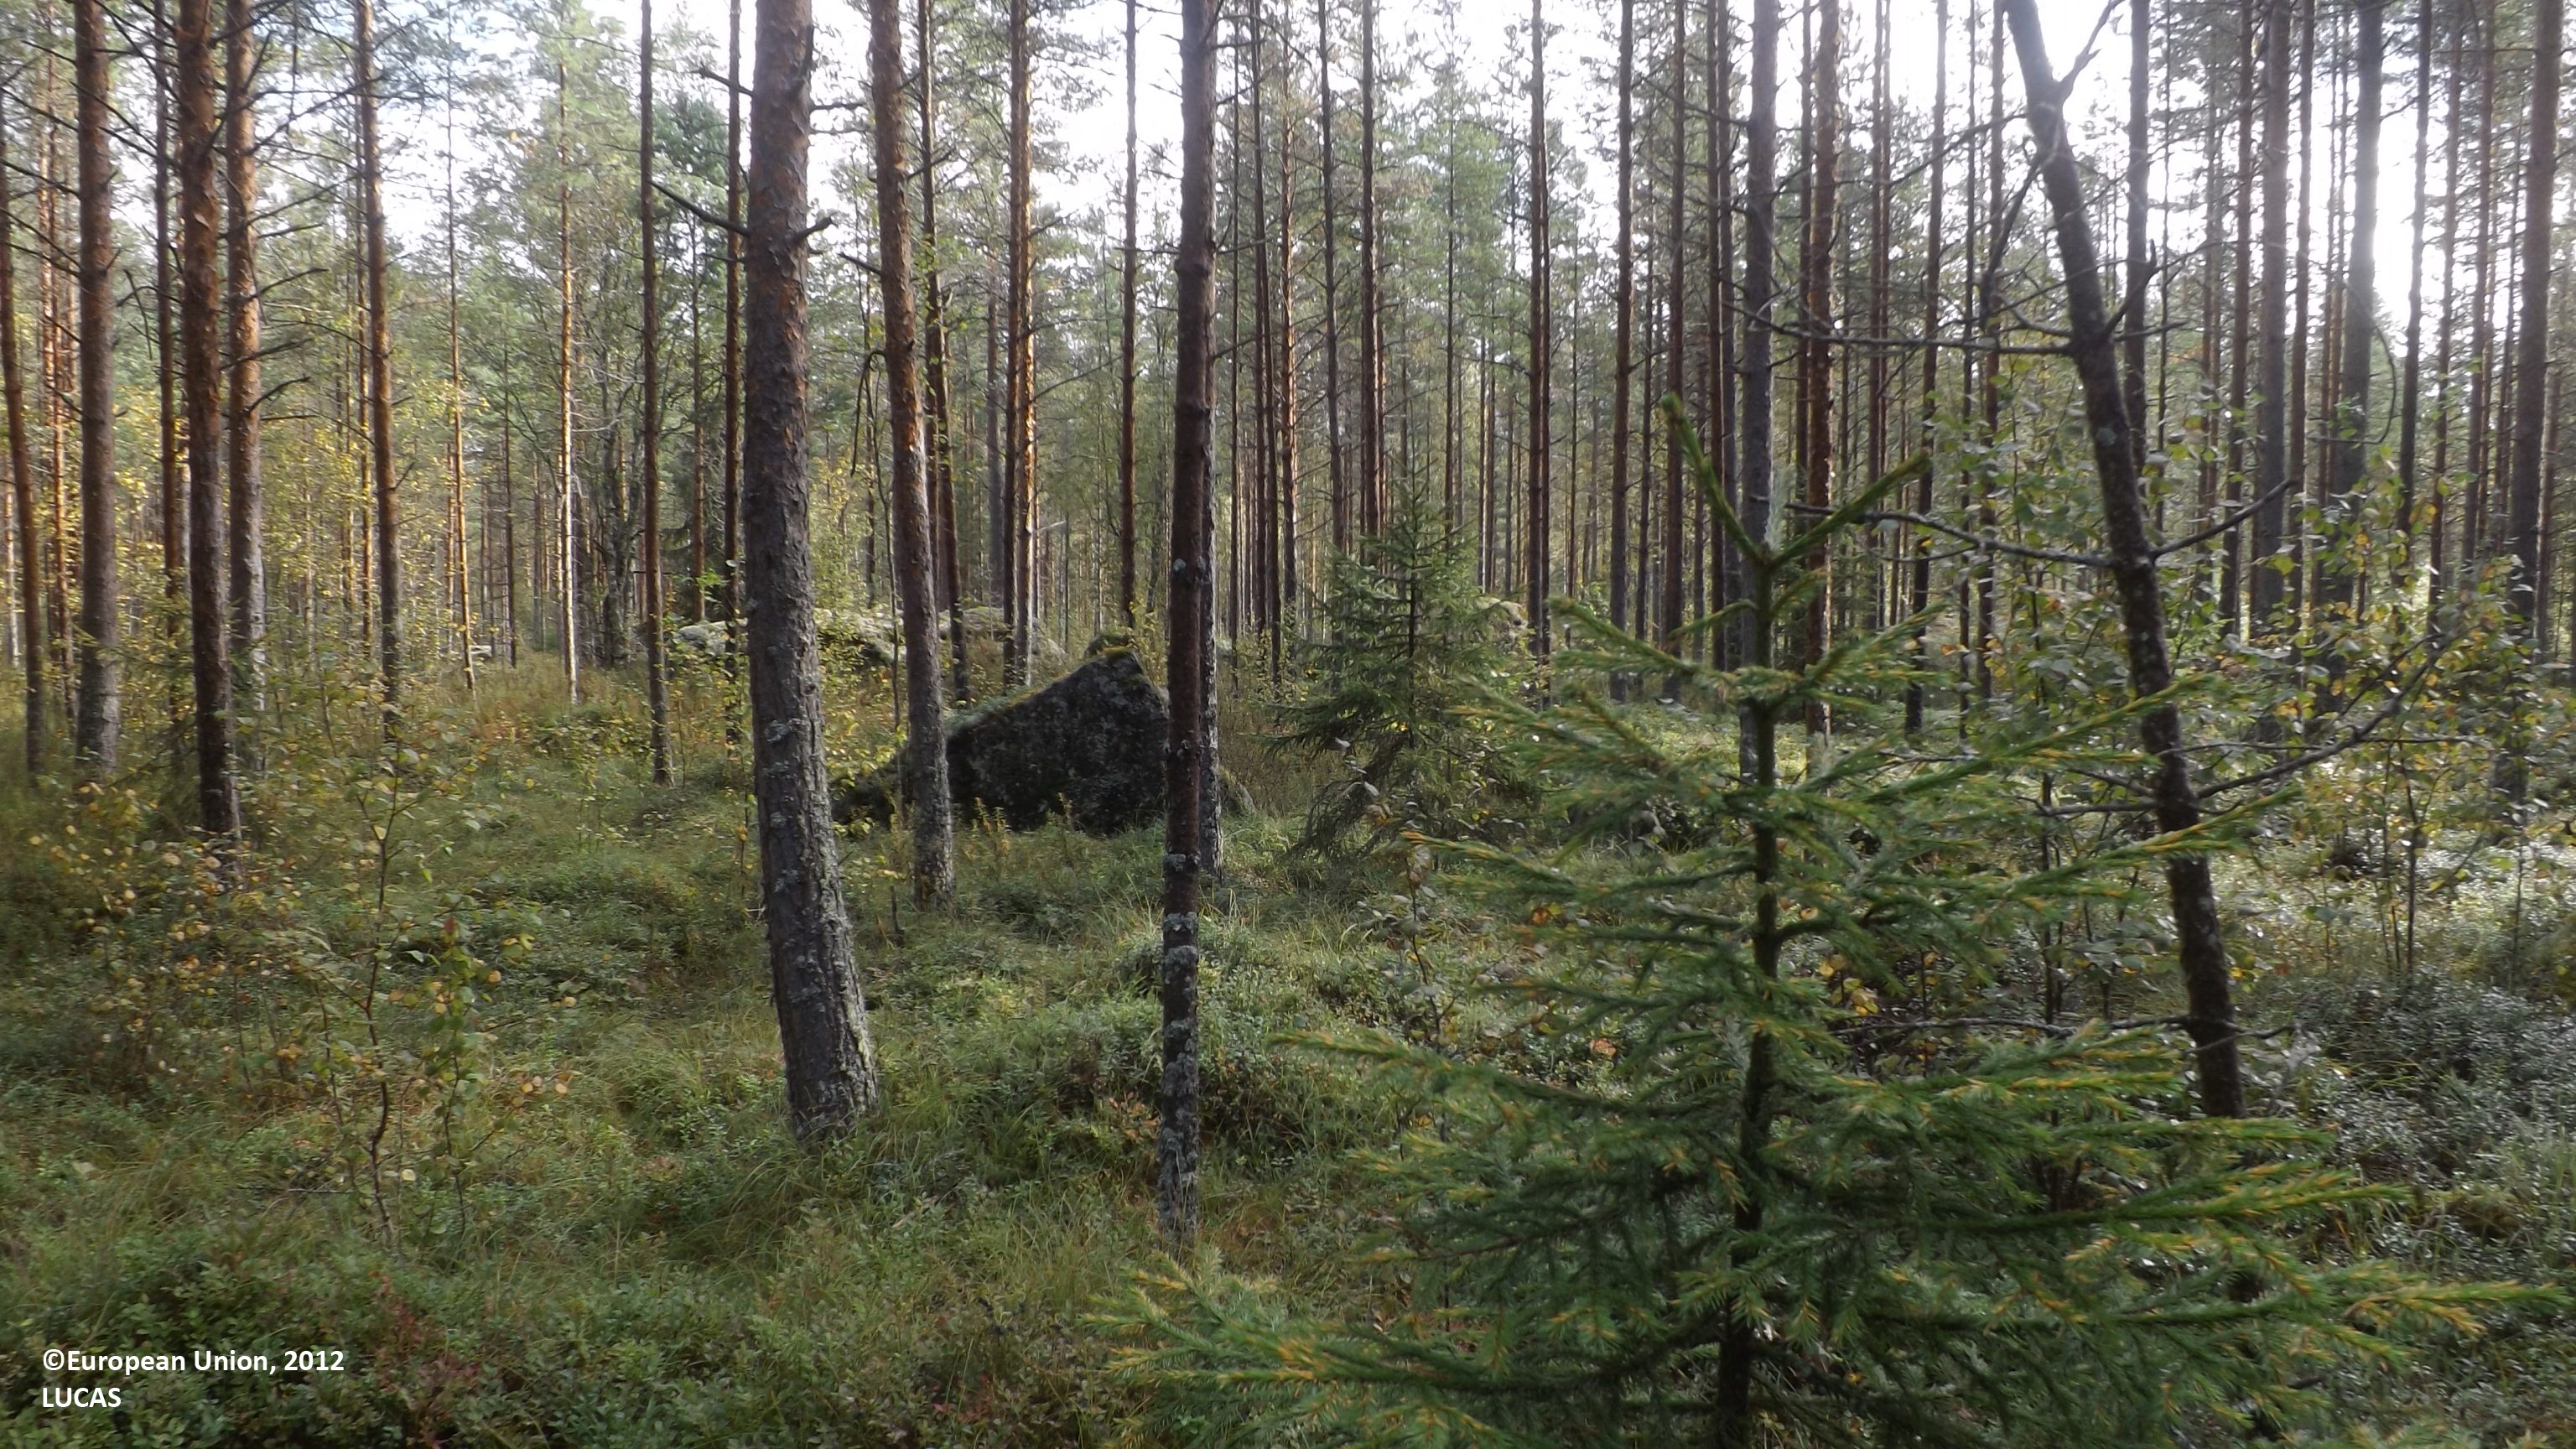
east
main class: Woodland
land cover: Pine dominated coniferous woodland
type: boreal forest
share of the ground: 50 - 75 %
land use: Forestry
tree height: > 5 m
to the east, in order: Pine dominated coniferous woodland; Pine dominated mixed woodland; Ditches and canals; Grass margins; Ditches and canals; Spruce dominated mixed woodland; Pine dominated mixed woodland; Shrubland with sparse tree cover
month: August
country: FI
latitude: 63.8510
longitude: 23.5431
